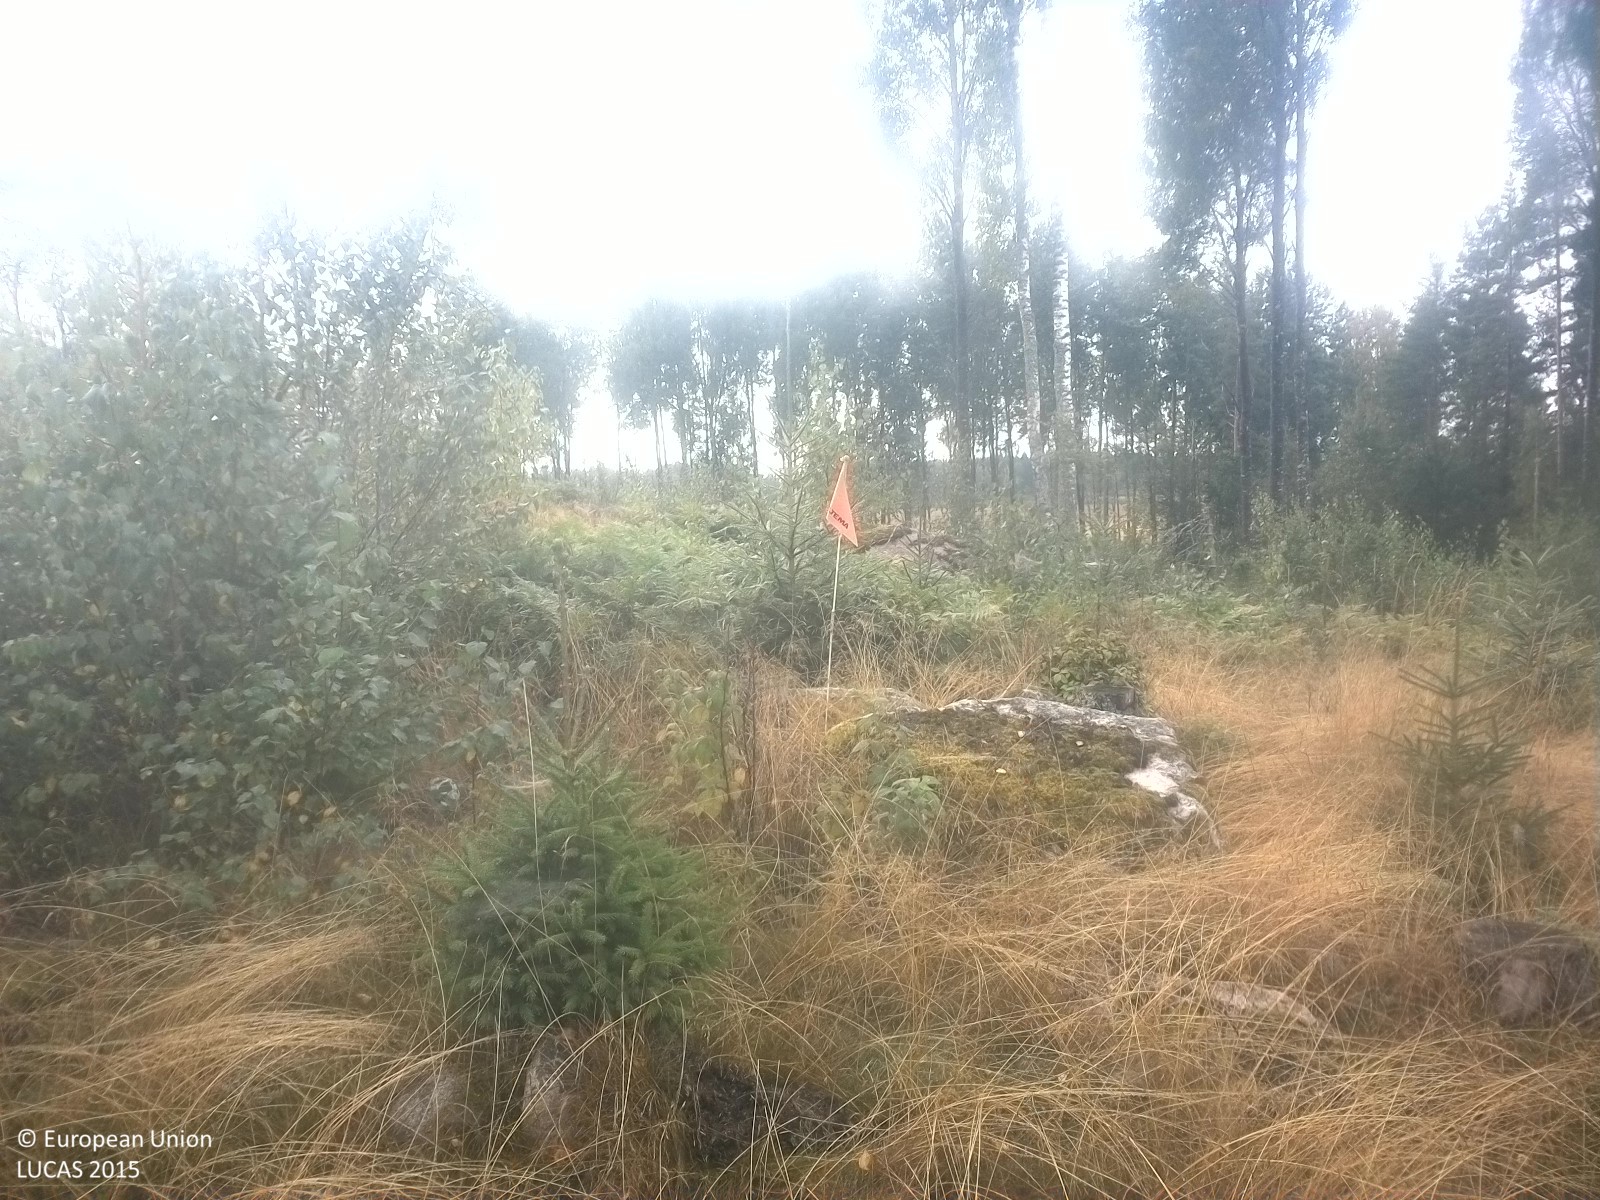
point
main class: Woodland
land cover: Spruce dominated mixed woodland
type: boreal forest
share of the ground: 25 - 50 %
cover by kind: herbaceous plants 35 %, coniferous forest trees 20 %, broadleaved forest trees 20 %, shrubs 10 %, lichens and mosses 10 %, consolidated bare surface 5 %
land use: Forestry
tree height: < 5 m
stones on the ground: 25 - 50 %
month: September
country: SE
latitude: 59.3626
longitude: 15.6742
